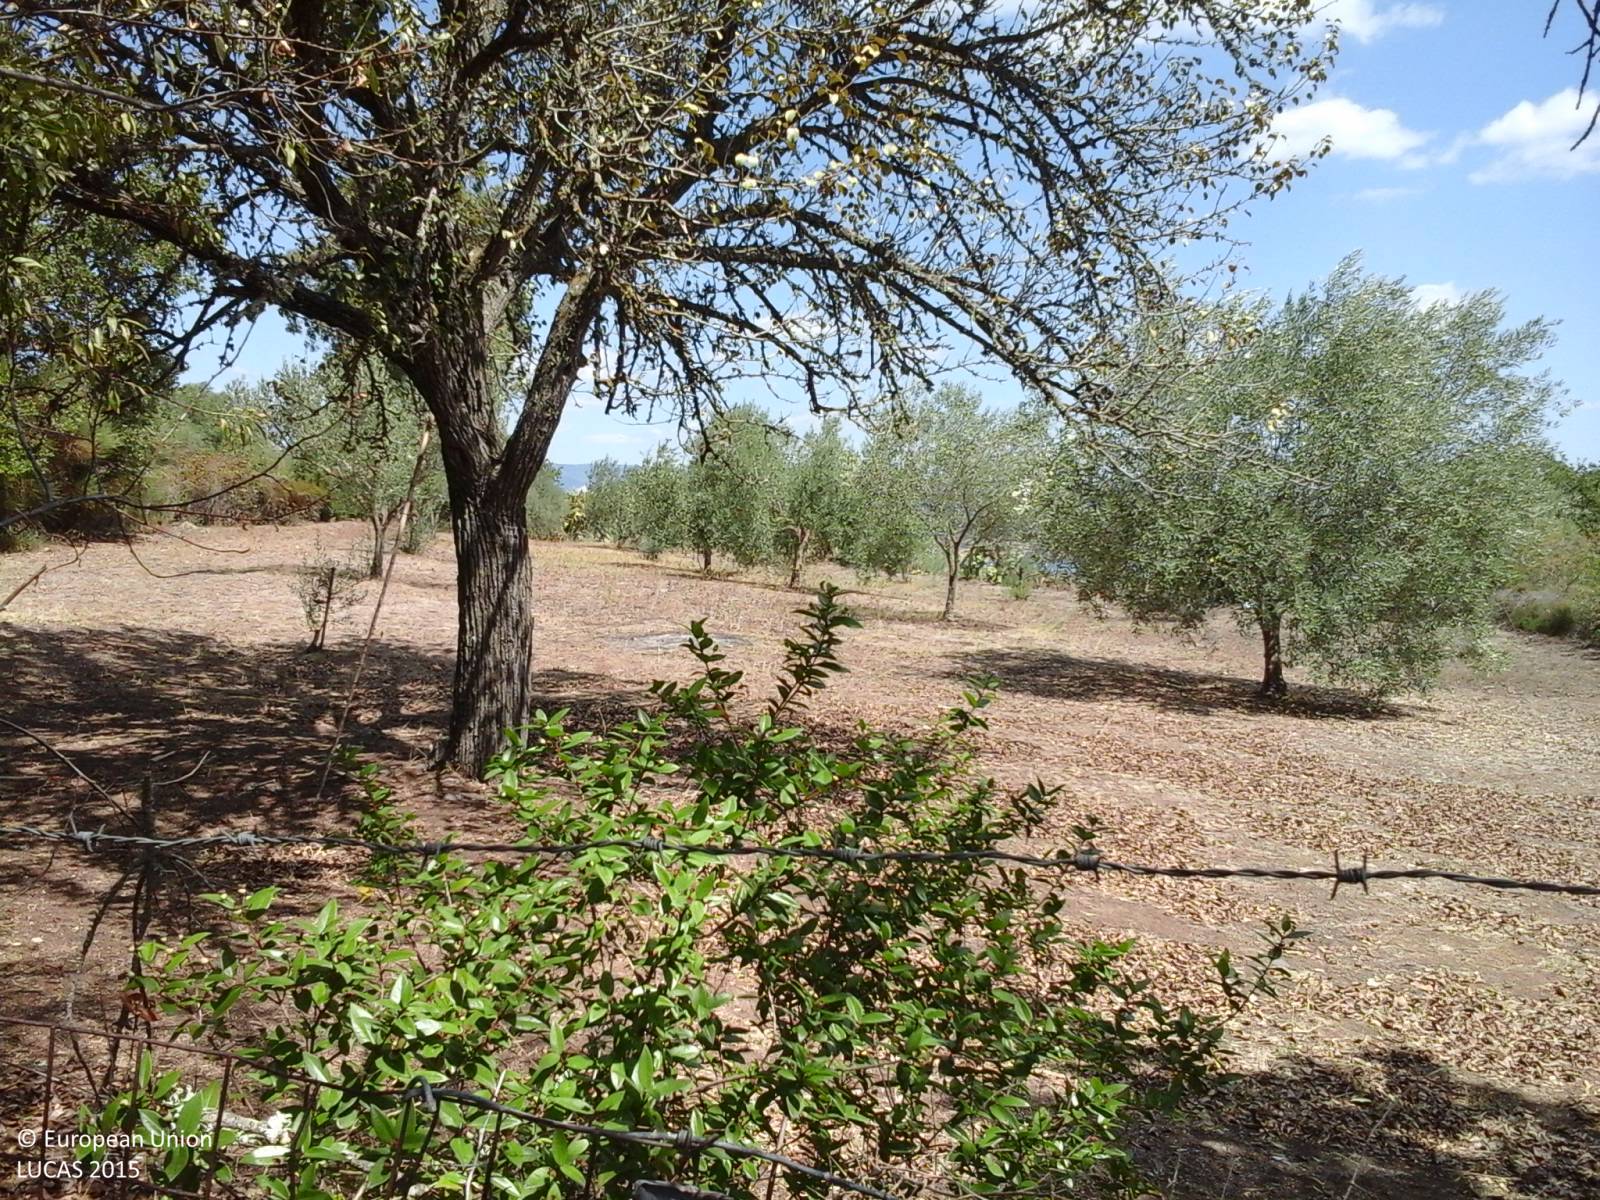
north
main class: Cropland
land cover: Olive groves
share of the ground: > 75 %
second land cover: Grassland without tree/shrub cover
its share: > 75 %
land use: Agriculture (excluding fallow land and kitchen gardens)
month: August
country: IT
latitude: 40.1162
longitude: 8.8913
